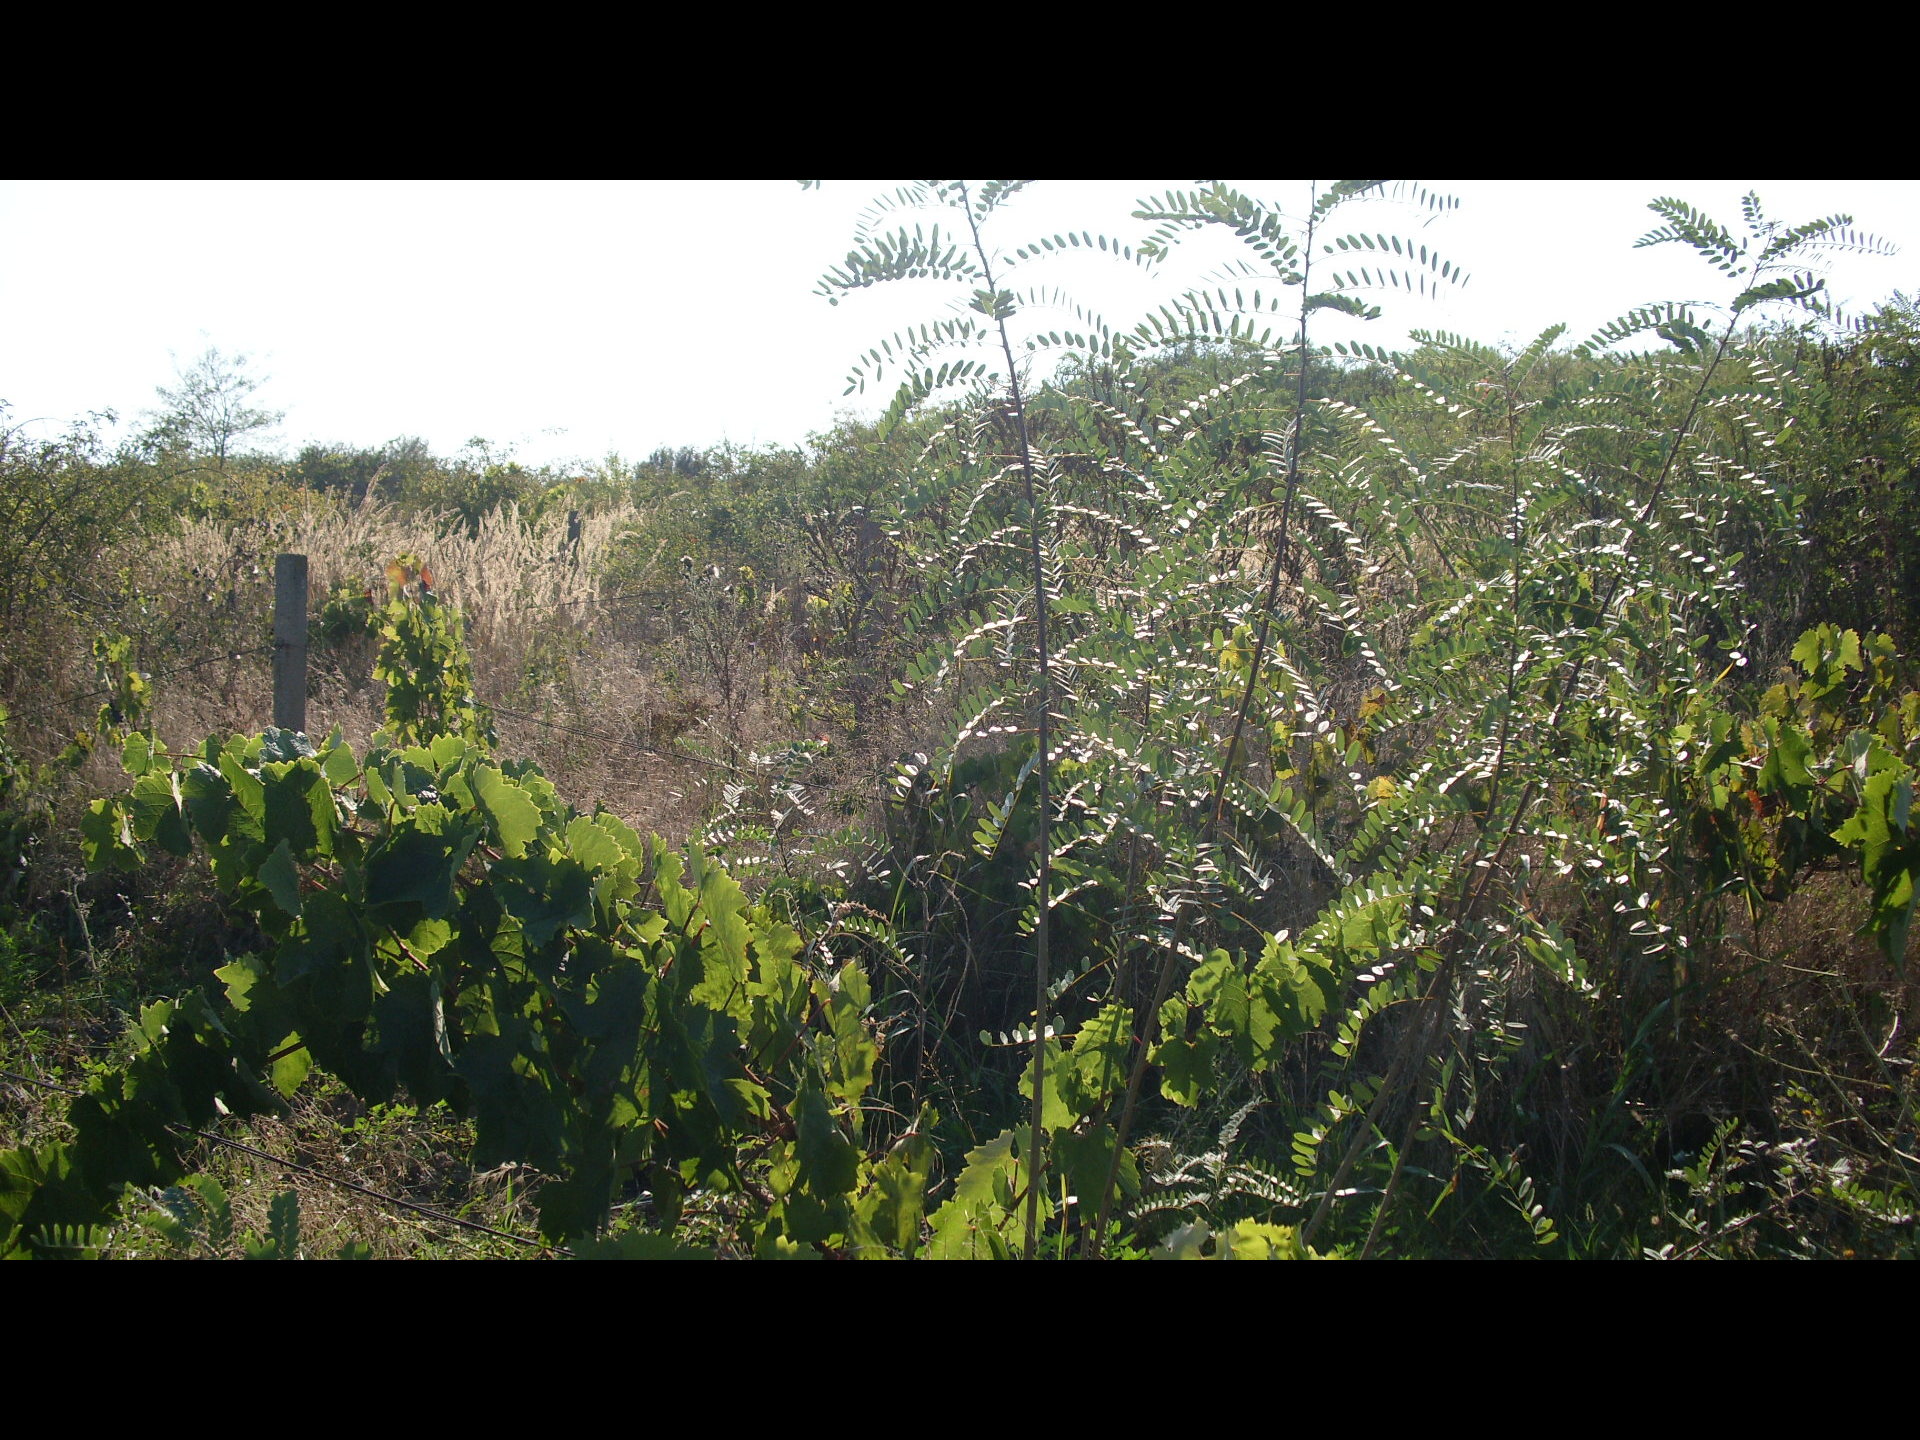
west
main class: Cropland
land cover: Vineyards
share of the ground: 50 - 75 %
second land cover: Spontaneously vegetated surfaces
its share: 25 - 50 %
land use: Agriculture (excluding fallow land and kitchen gardens)
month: August
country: BG
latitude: 44.1292
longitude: 22.7240
